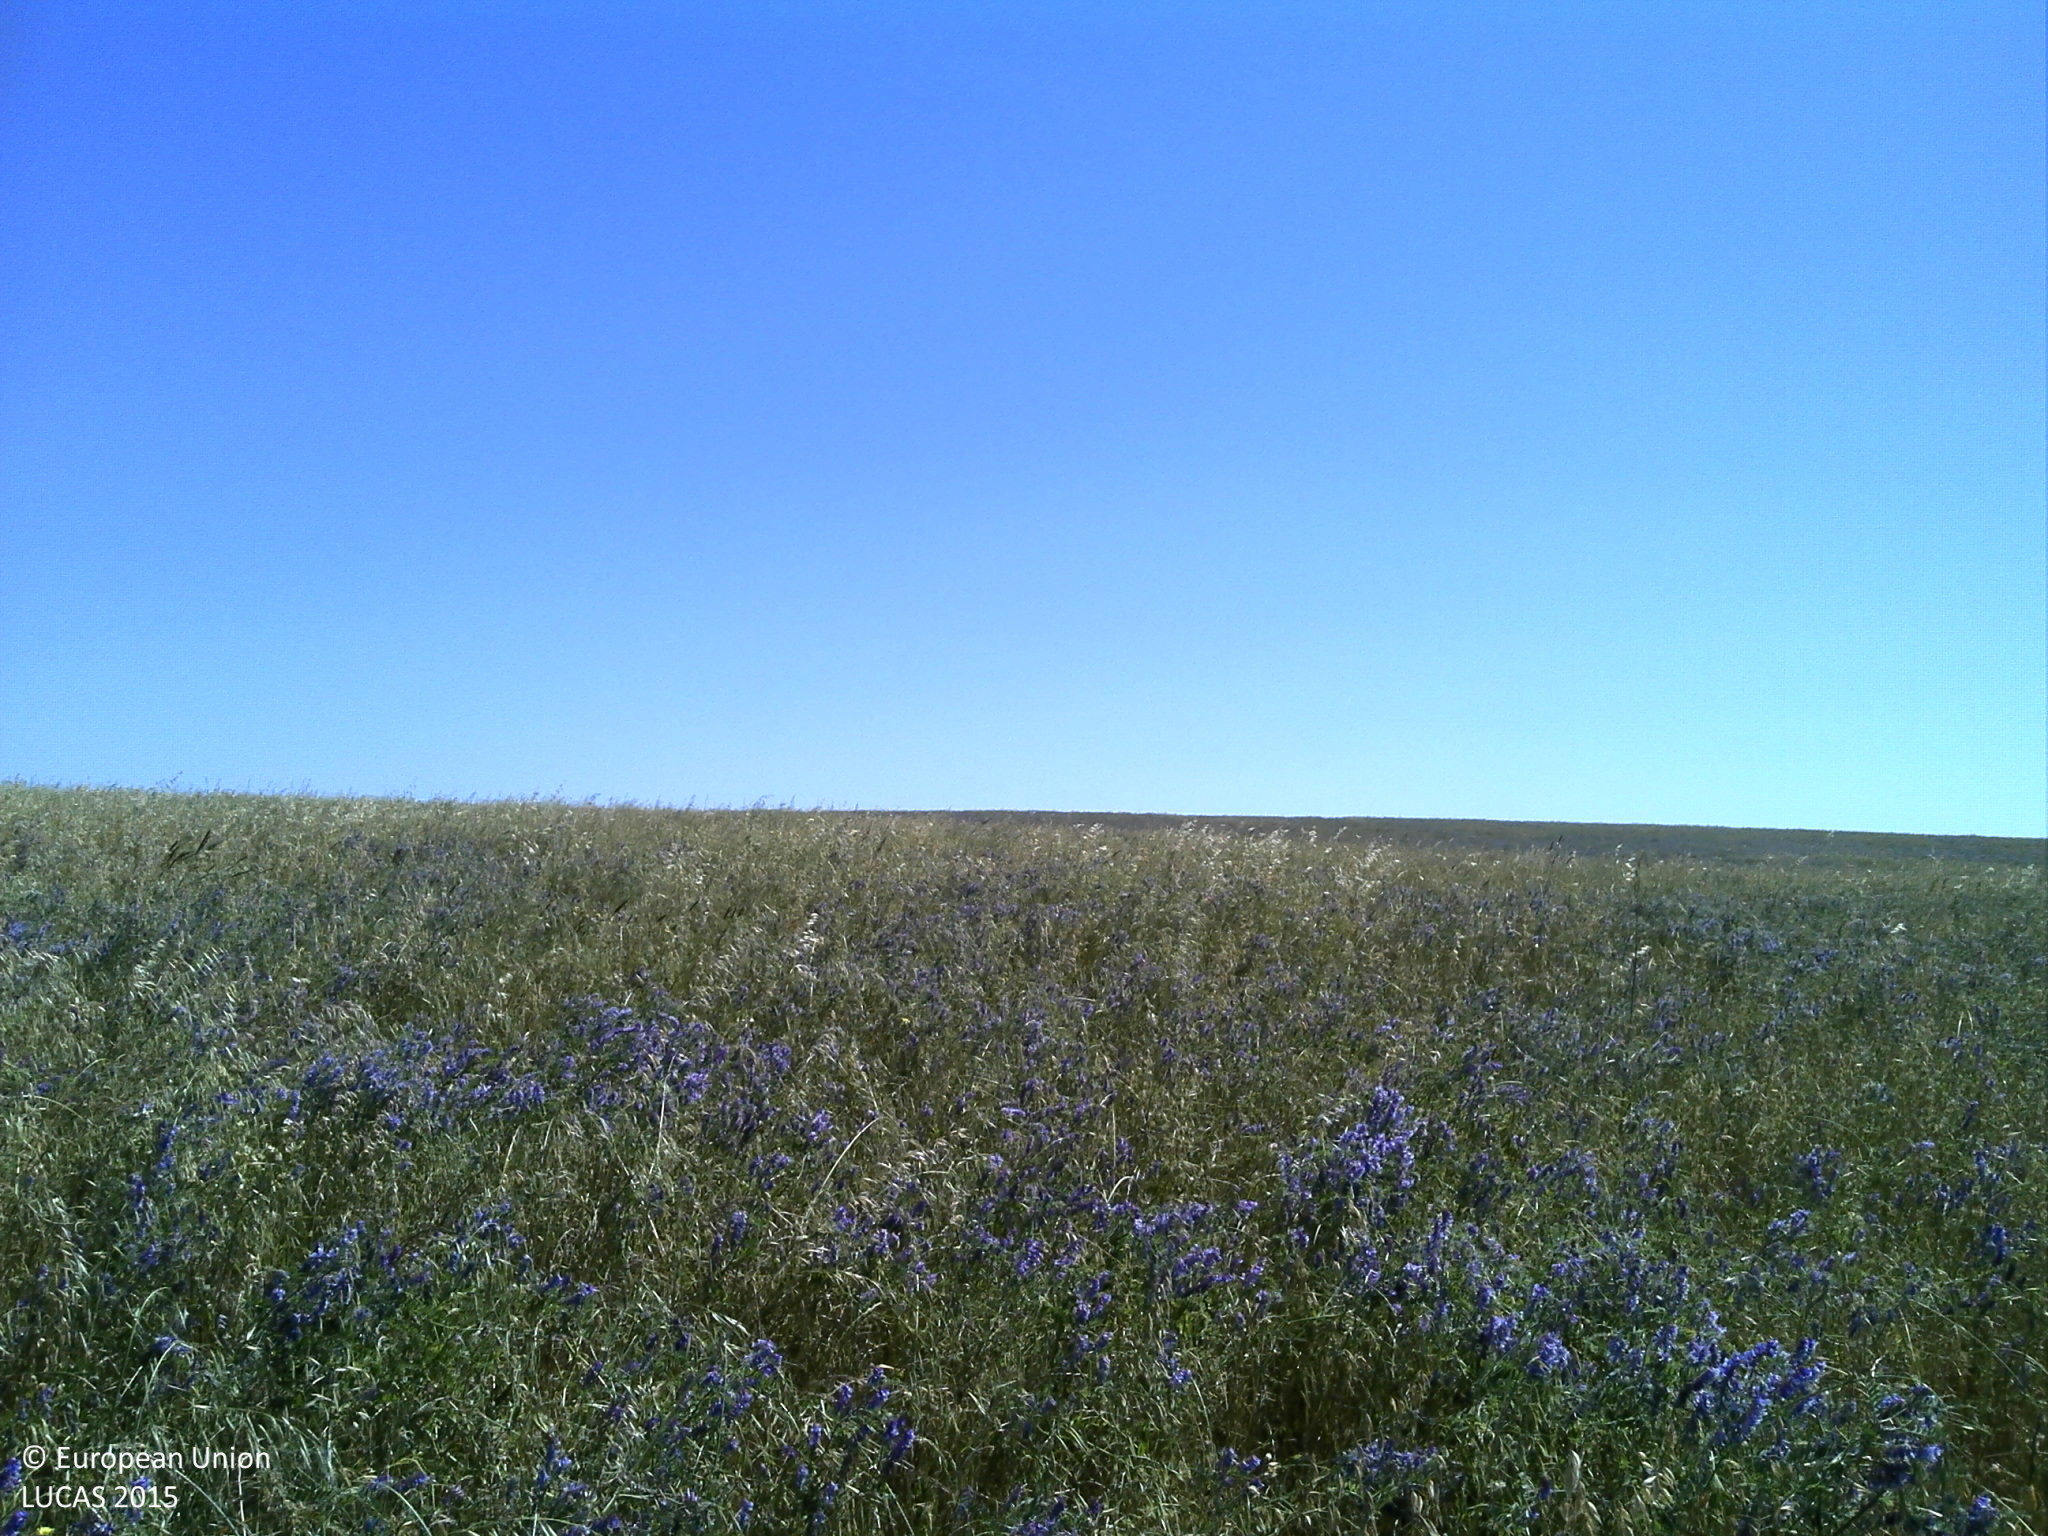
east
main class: Cropland
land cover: Temporary grasslands
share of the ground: > 75 %
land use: Agriculture (excluding fallow land and kitchen gardens)
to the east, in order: Temporary grasslands
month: May
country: PT
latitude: 39.1717
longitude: -7.8394
